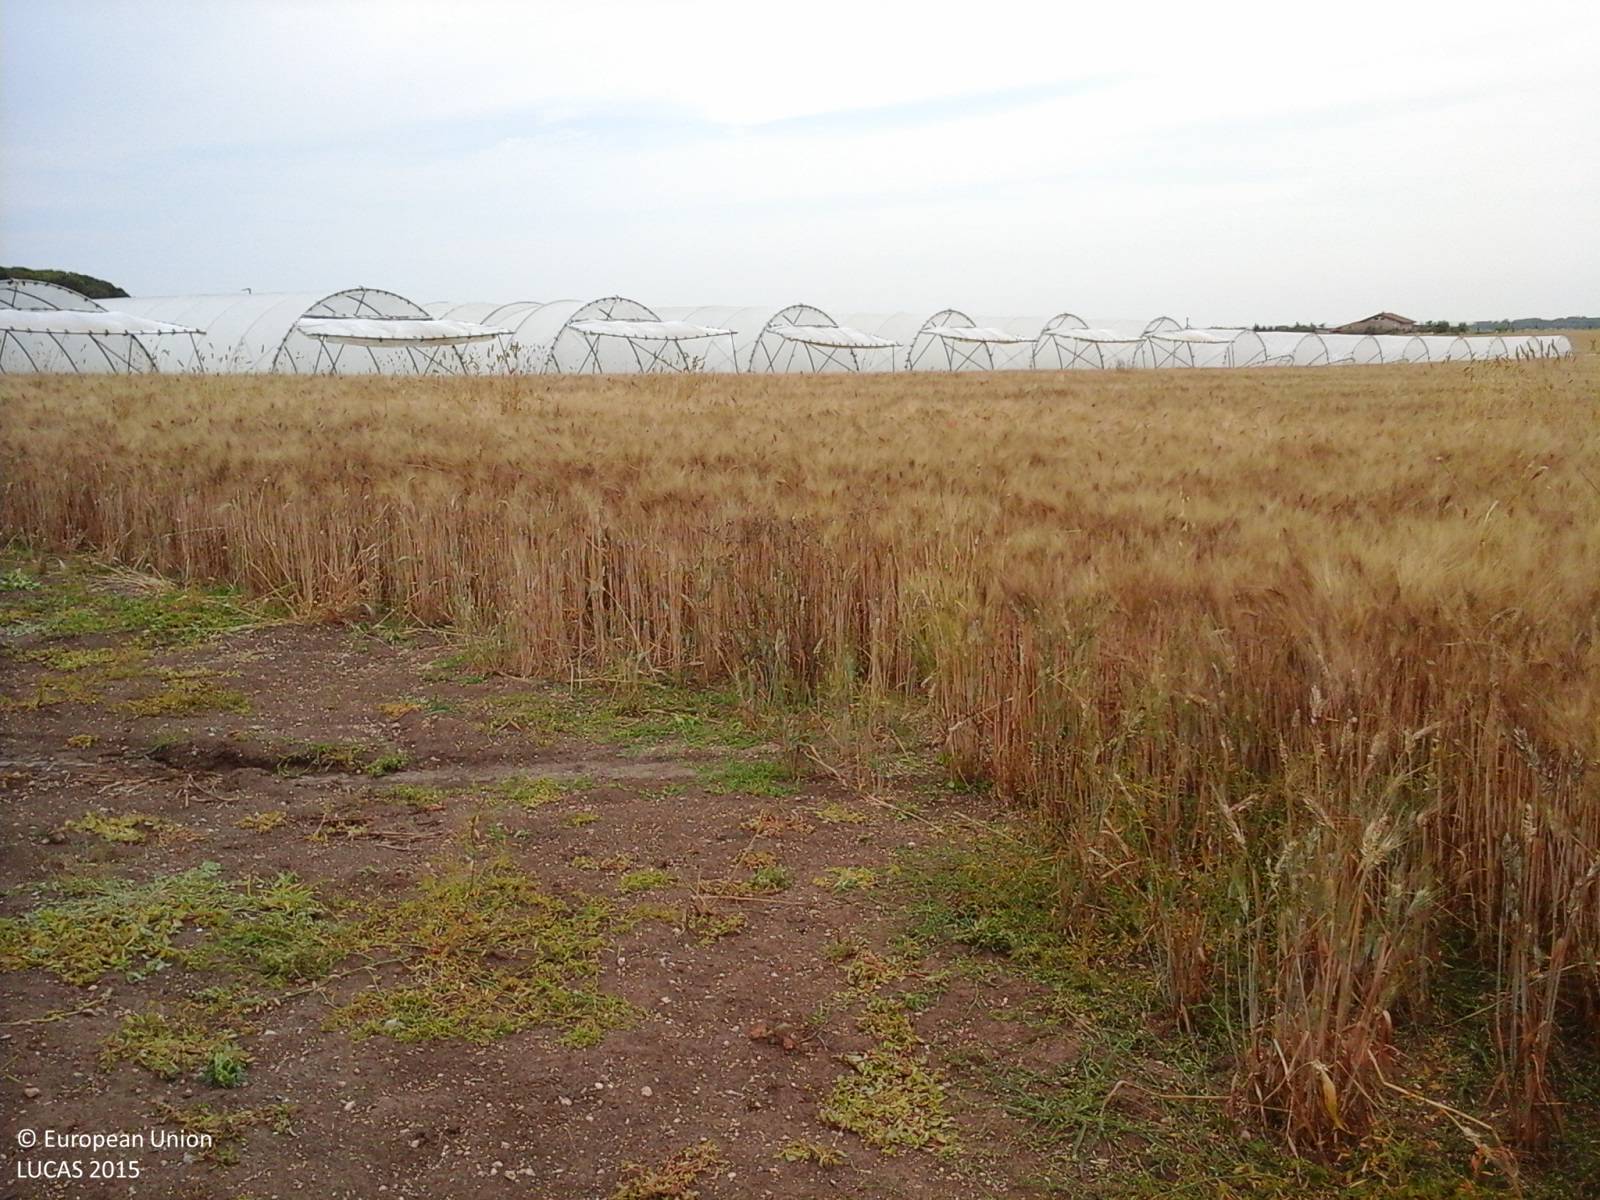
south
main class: Cropland
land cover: Durum wheat
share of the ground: > 75 %
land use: Agriculture (excluding fallow land and kitchen gardens)
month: June
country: IT
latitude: 42.3905
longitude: 11.4647
